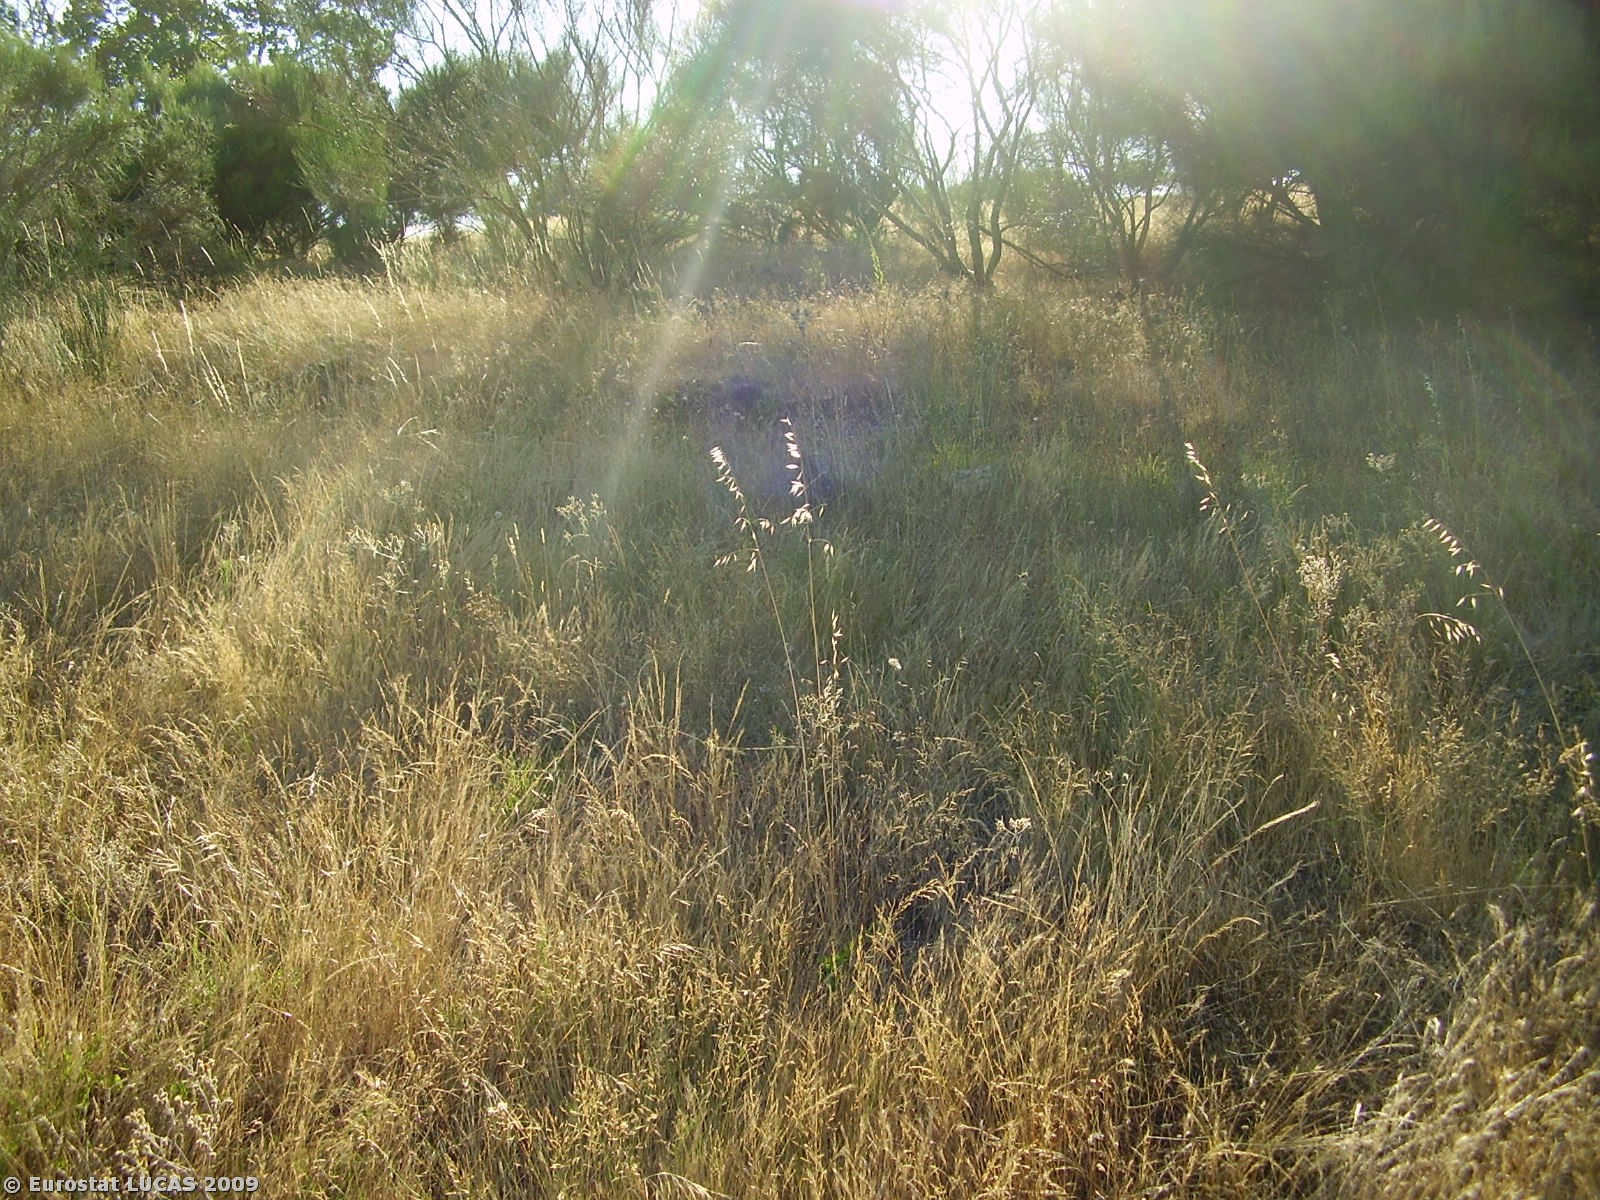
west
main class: Grassland
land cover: Spontaneously vegetated surfaces
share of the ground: > 75 %
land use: Unused
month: July
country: PT
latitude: 41.6887
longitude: -7.3920
